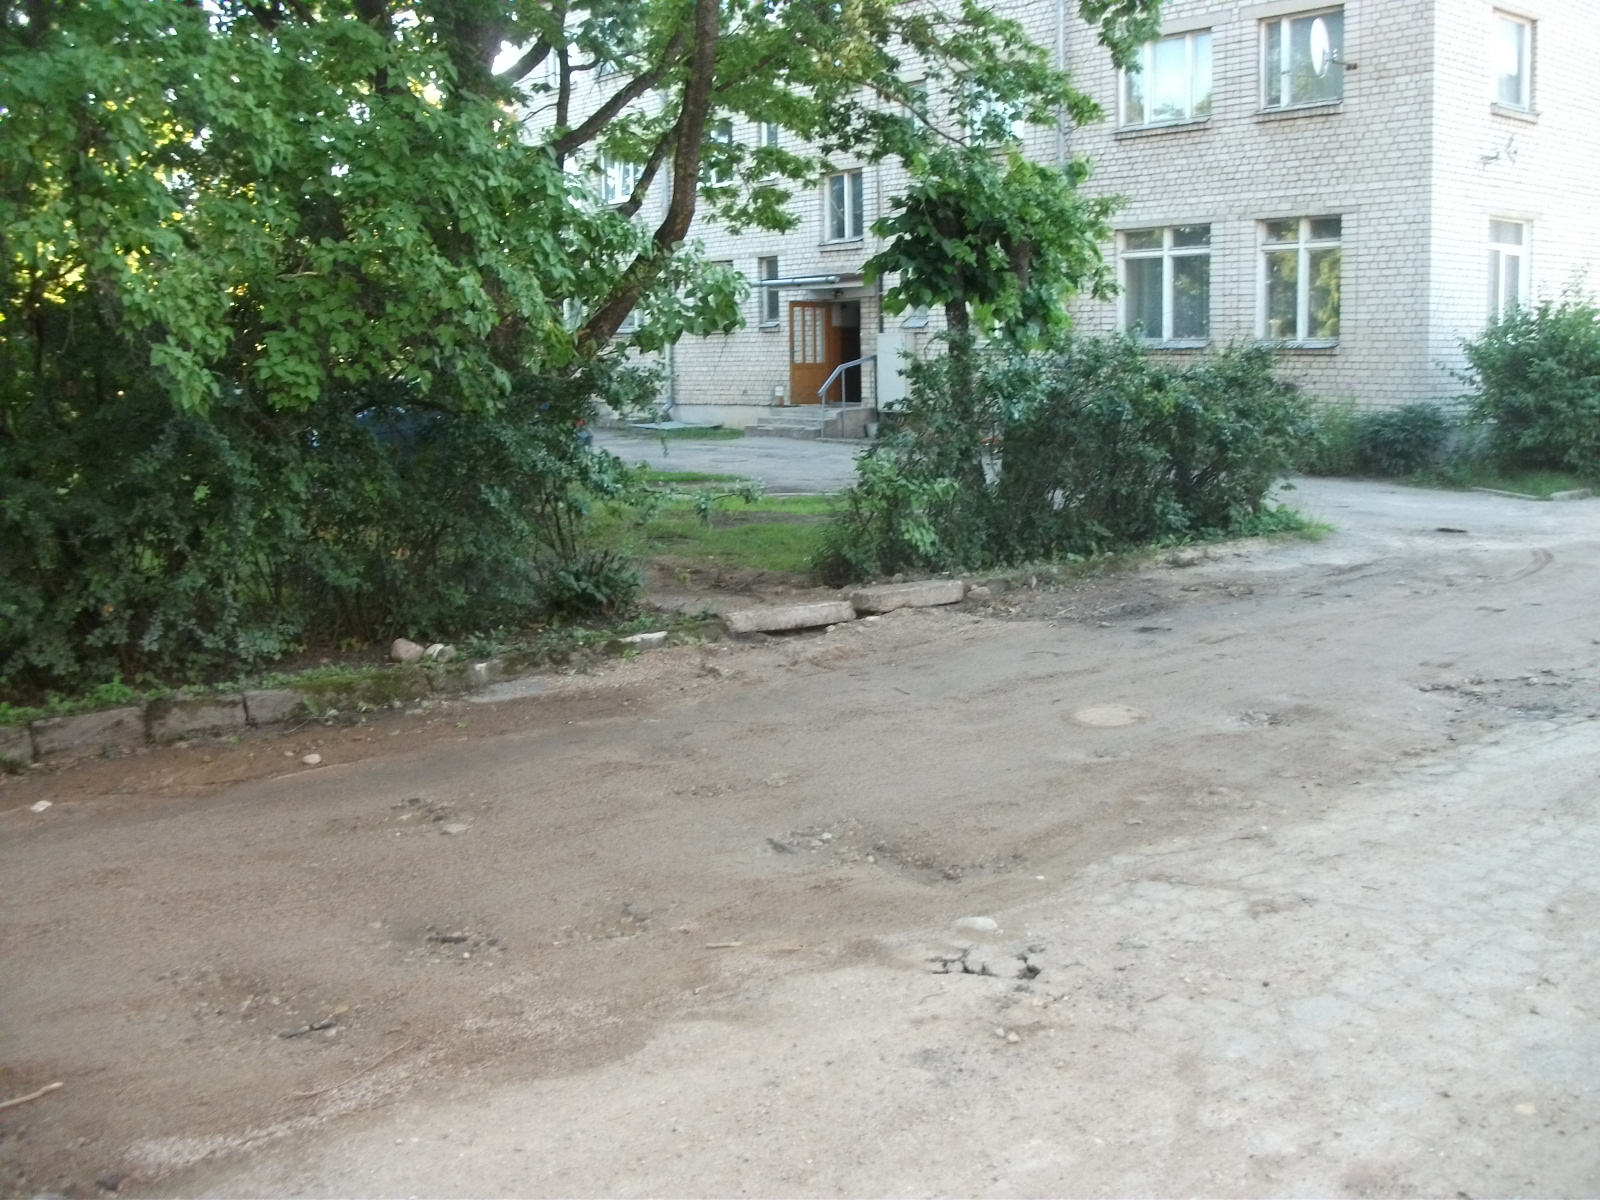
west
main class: Grassland
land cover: Grassland without tree/shrub cover
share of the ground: > 75 %
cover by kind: herbaceous plants 90 %, unconsolidated bare surface 10 %
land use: Residential
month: August
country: LV
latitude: 56.8551
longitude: 26.2256
